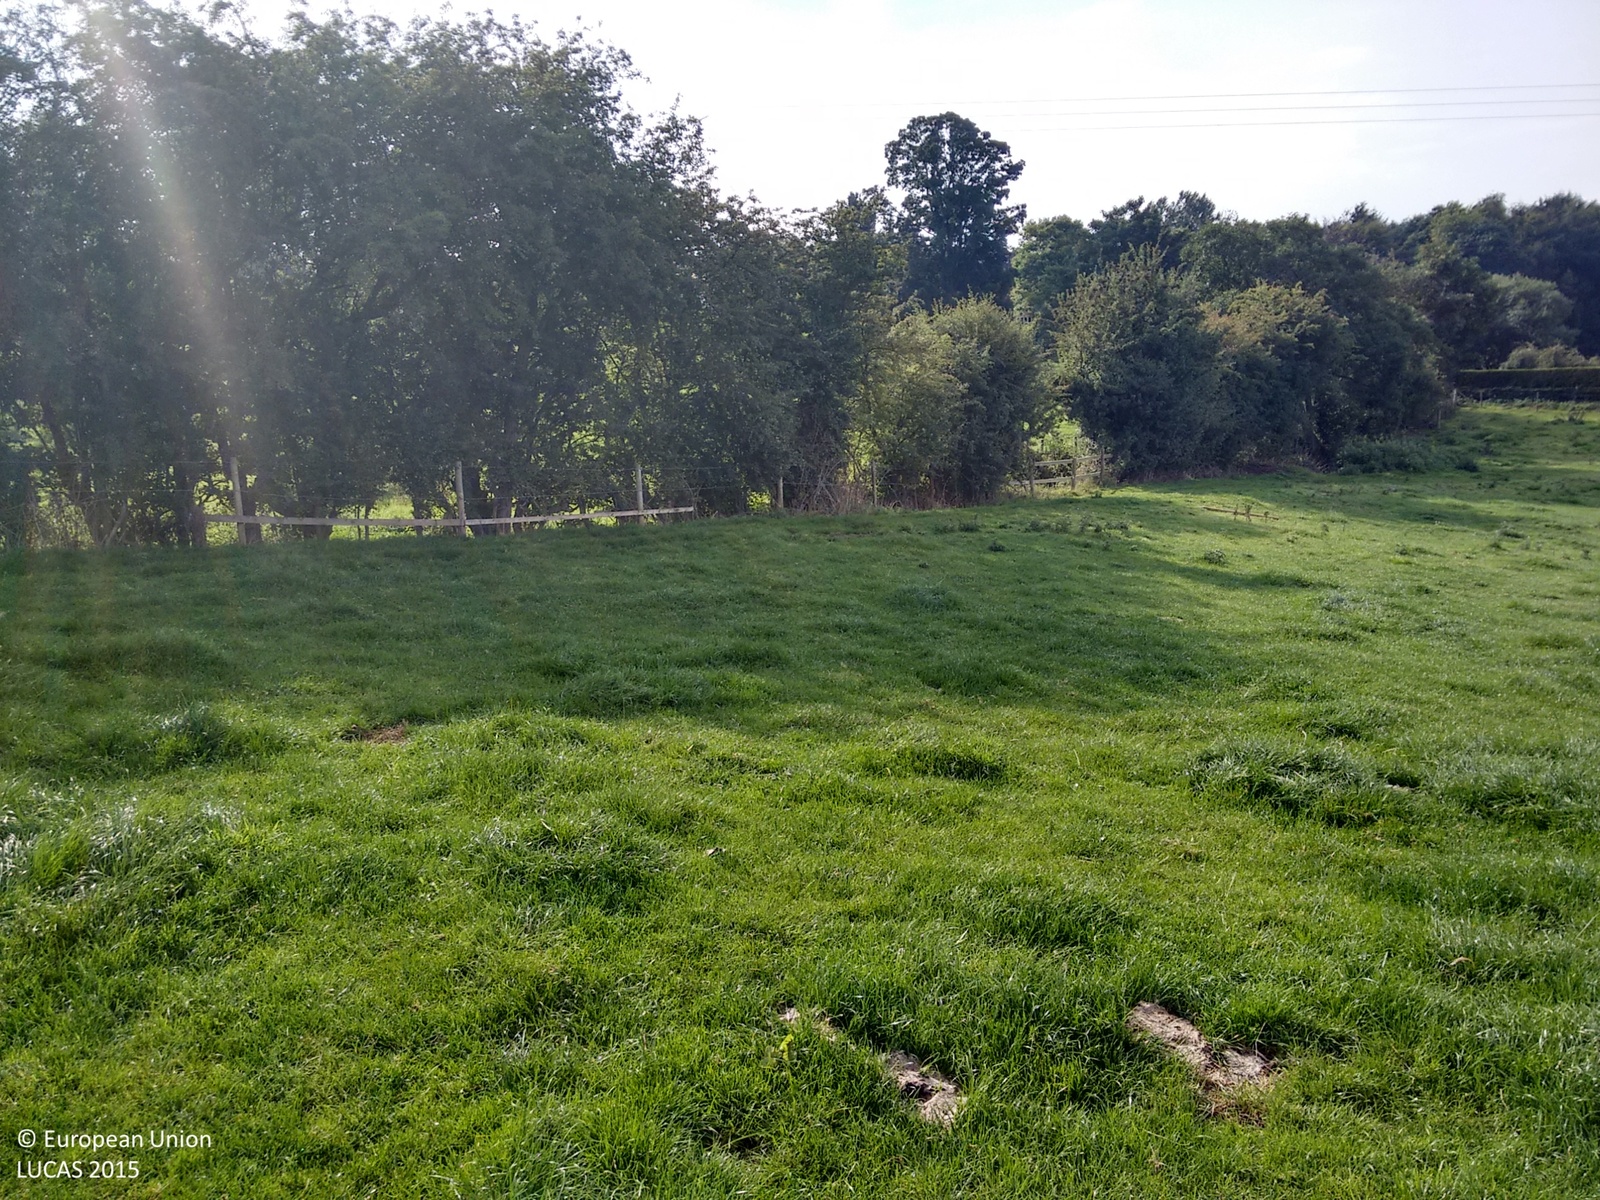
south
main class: Grassland
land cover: Grassland without tree/shrub cover
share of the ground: > 75 %
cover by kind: herbaceous plants 100 %
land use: Agriculture (excluding fallow land and kitchen gardens)
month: September
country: GB
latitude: 52.9863
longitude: -2.6859
